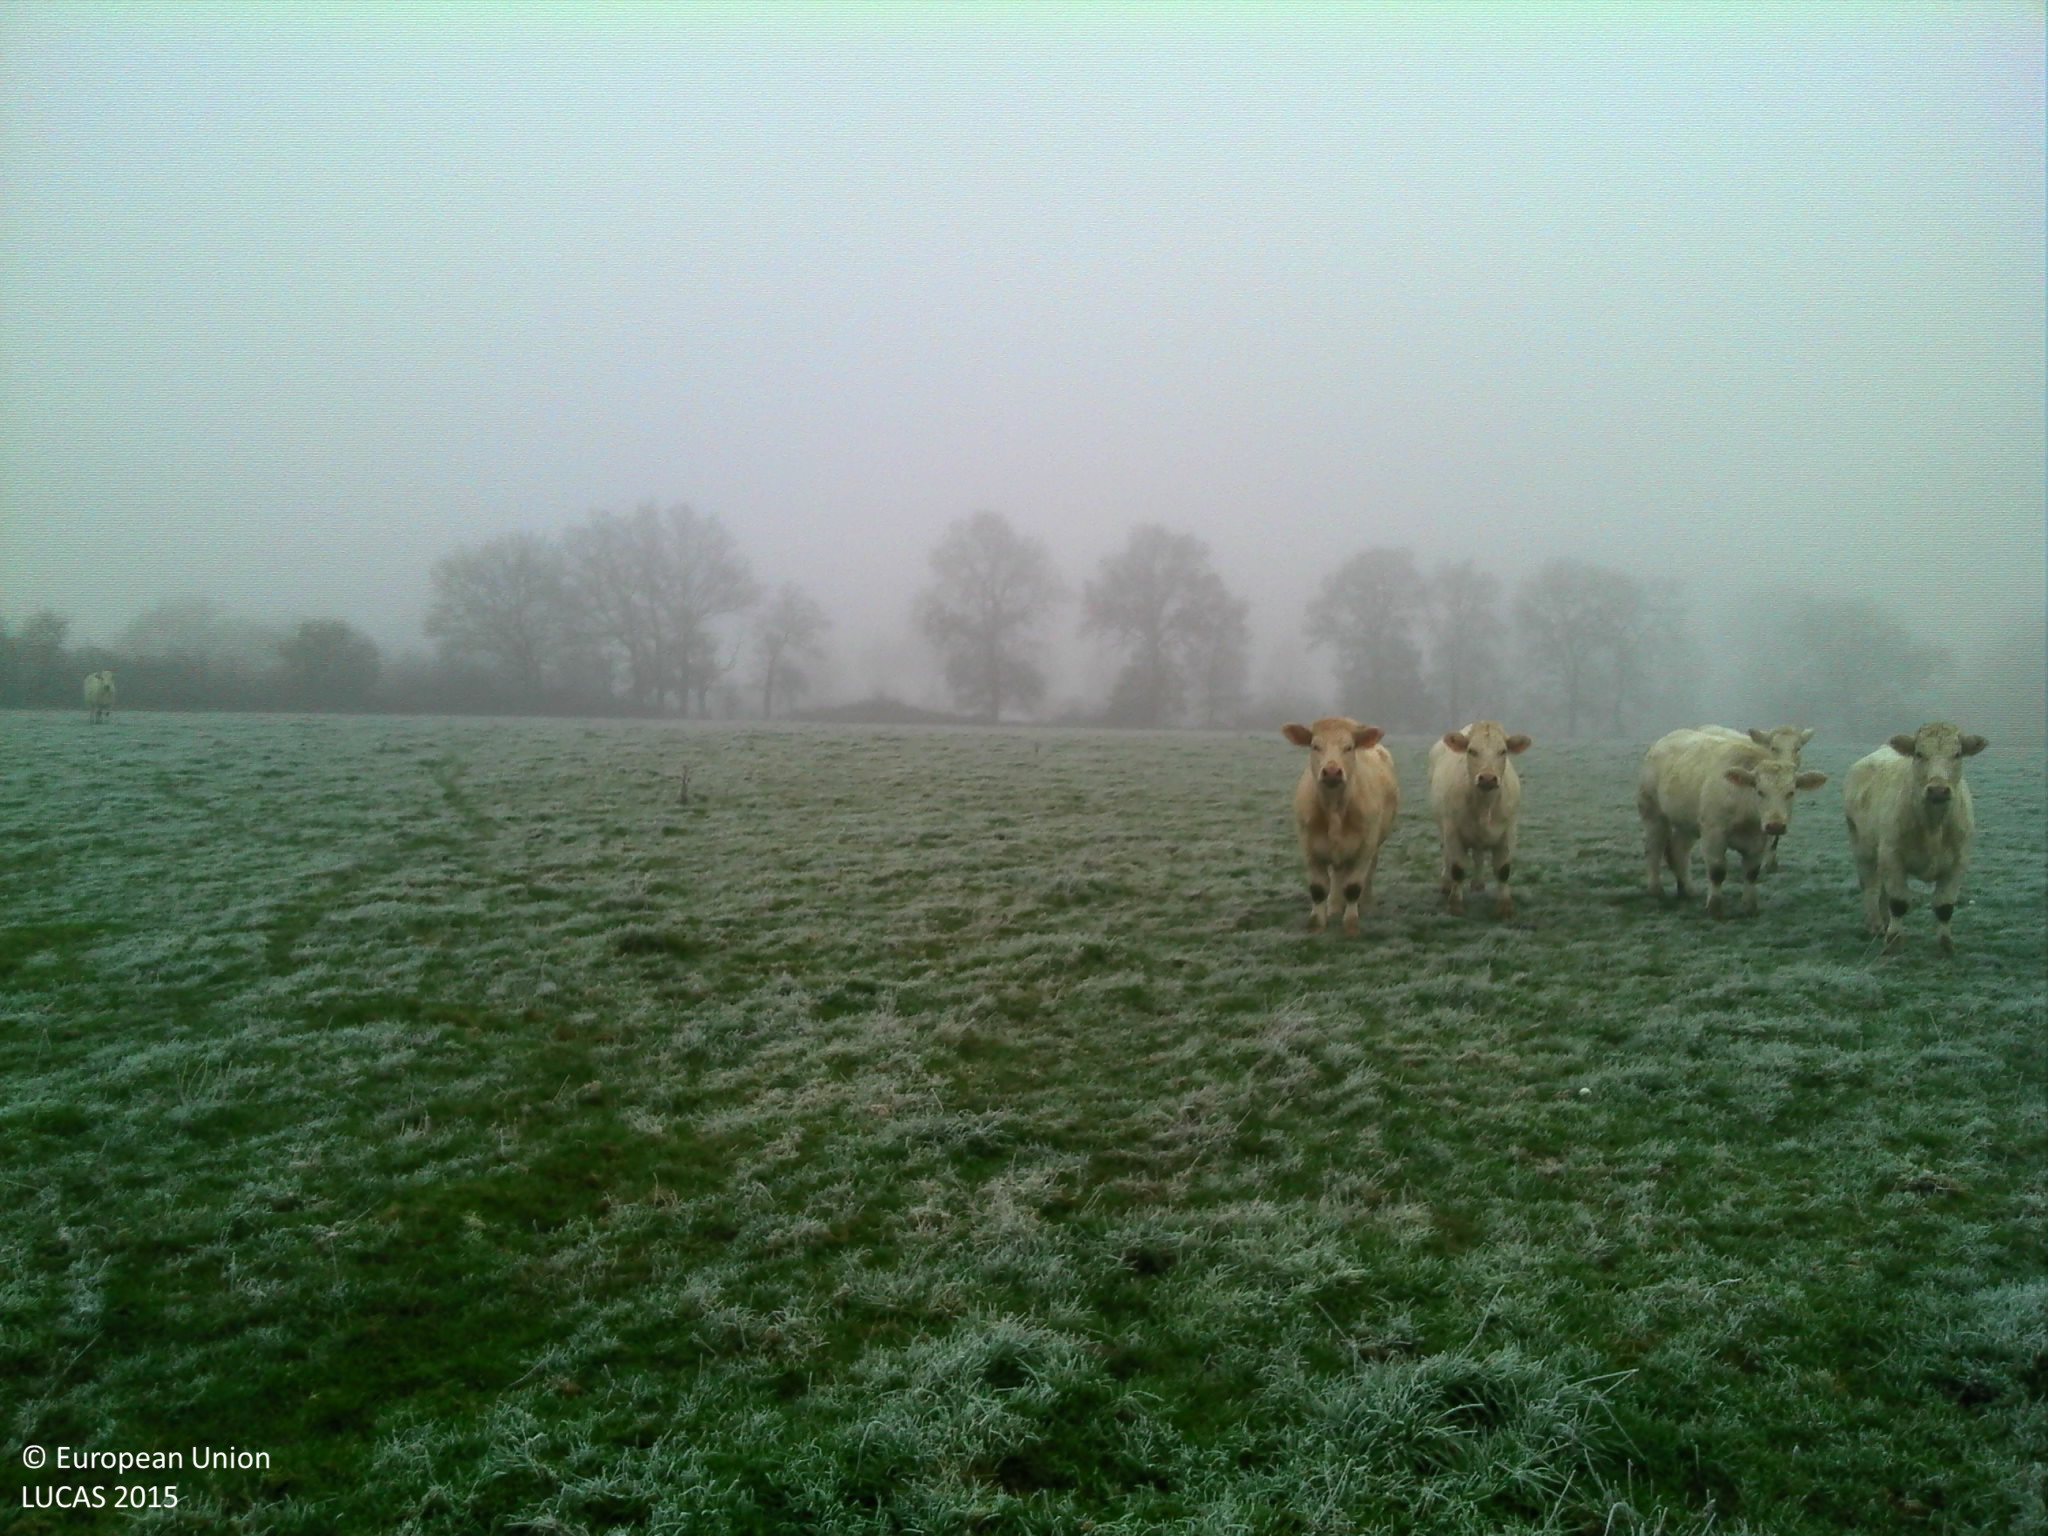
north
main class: Grassland
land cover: Grassland without tree/shrub cover
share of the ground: > 75 %
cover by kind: herbaceous plants 100 %
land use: Agriculture (excluding fallow land and kitchen gardens)
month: November
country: FR
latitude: 46.6135
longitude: 3.6400
